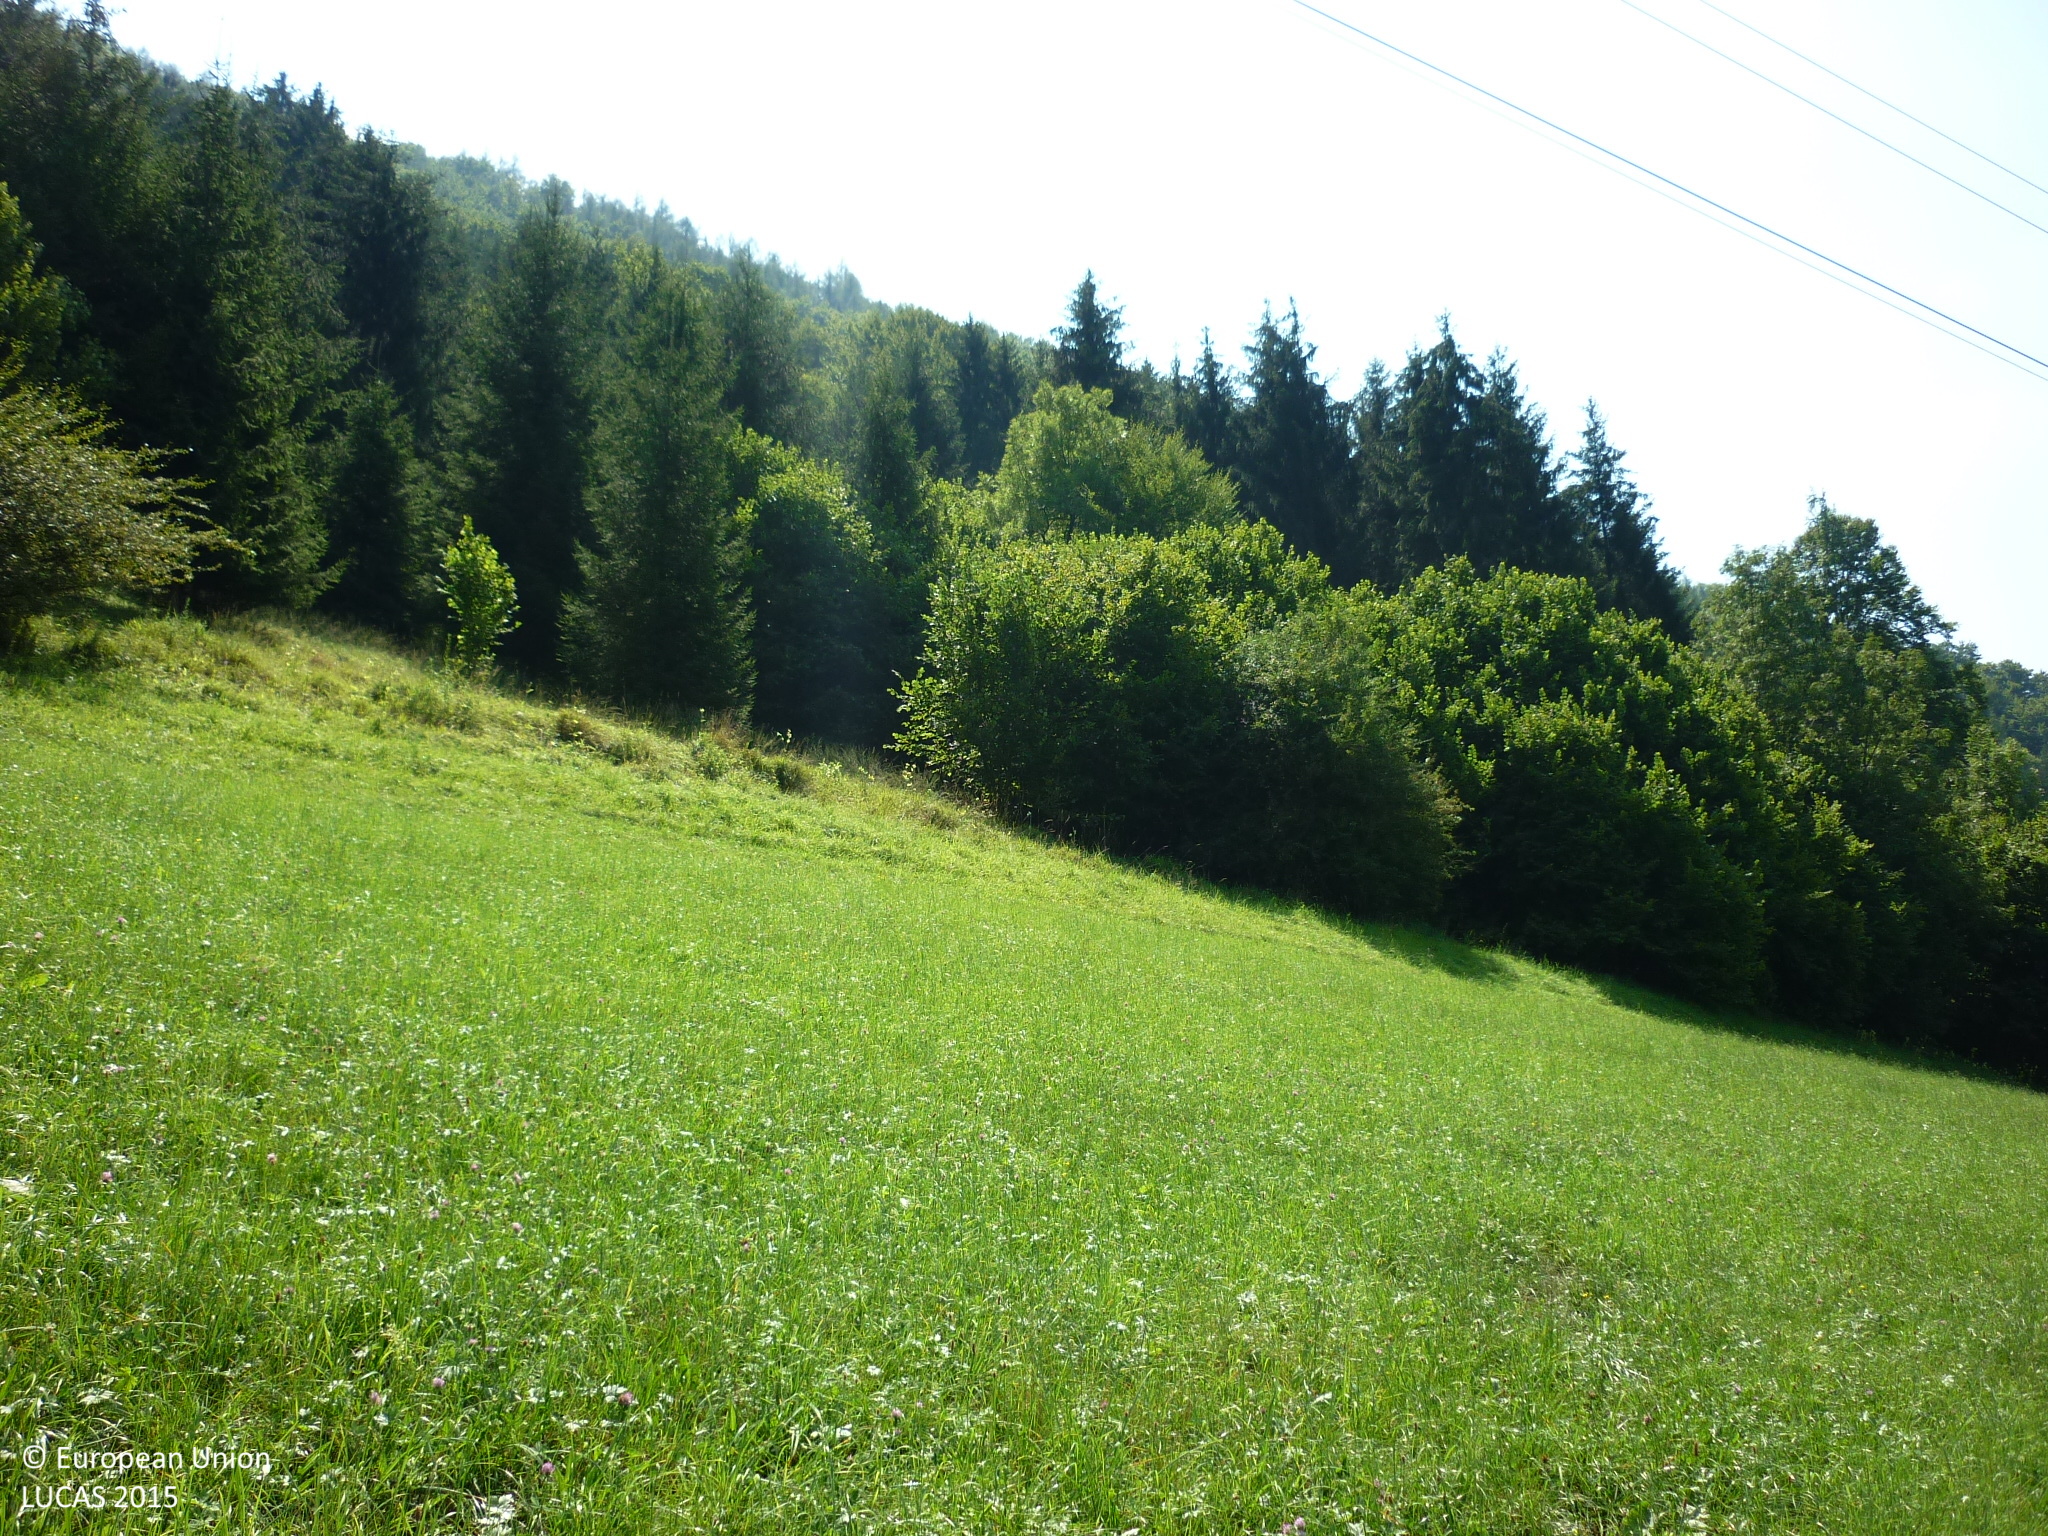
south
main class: Grassland
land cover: Grassland without tree/shrub cover
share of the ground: > 75 %
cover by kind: herbaceous plants 100 %
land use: Agriculture (excluding fallow land and kitchen gardens)
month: August
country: AT
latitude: 47.8893
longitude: 14.6944
